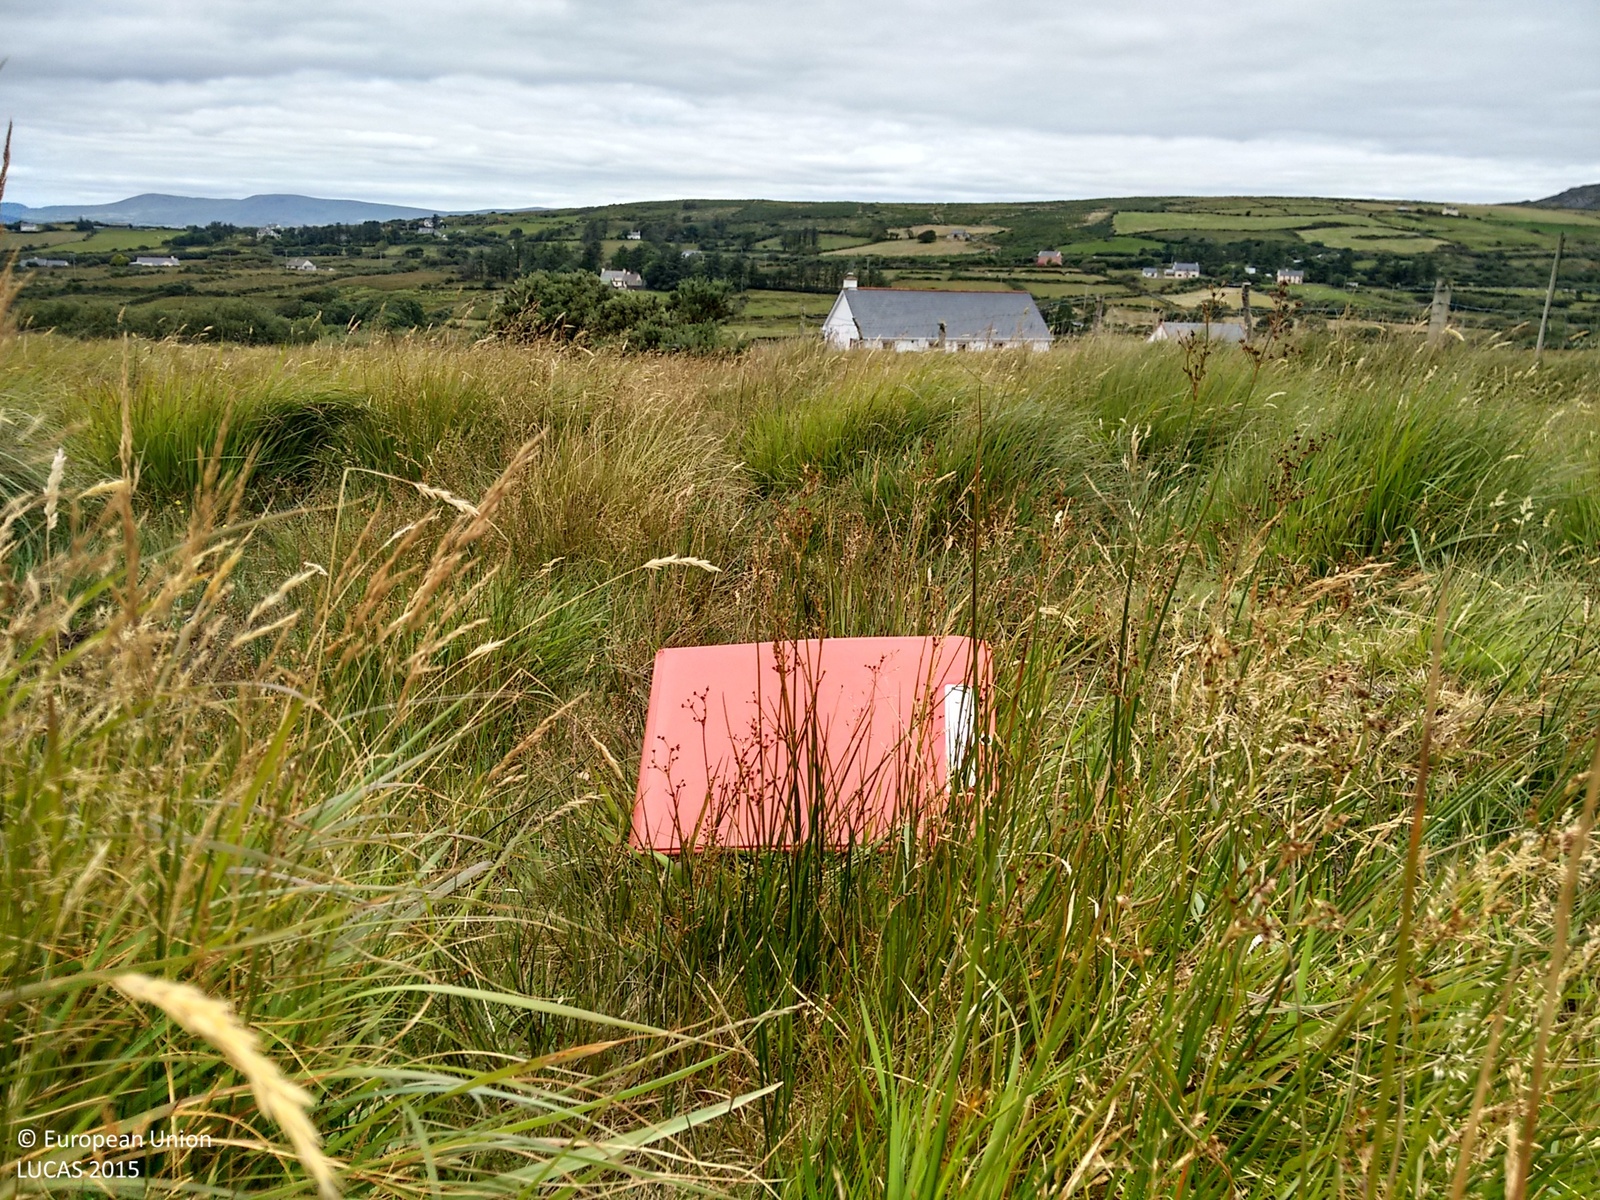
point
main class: Grassland
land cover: Grassland without tree/shrub cover
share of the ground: > 75 %
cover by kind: herbaceous plants 100 %
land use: Agriculture (excluding fallow land and kitchen gardens)
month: August
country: IE
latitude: 51.6808
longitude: -9.9351
